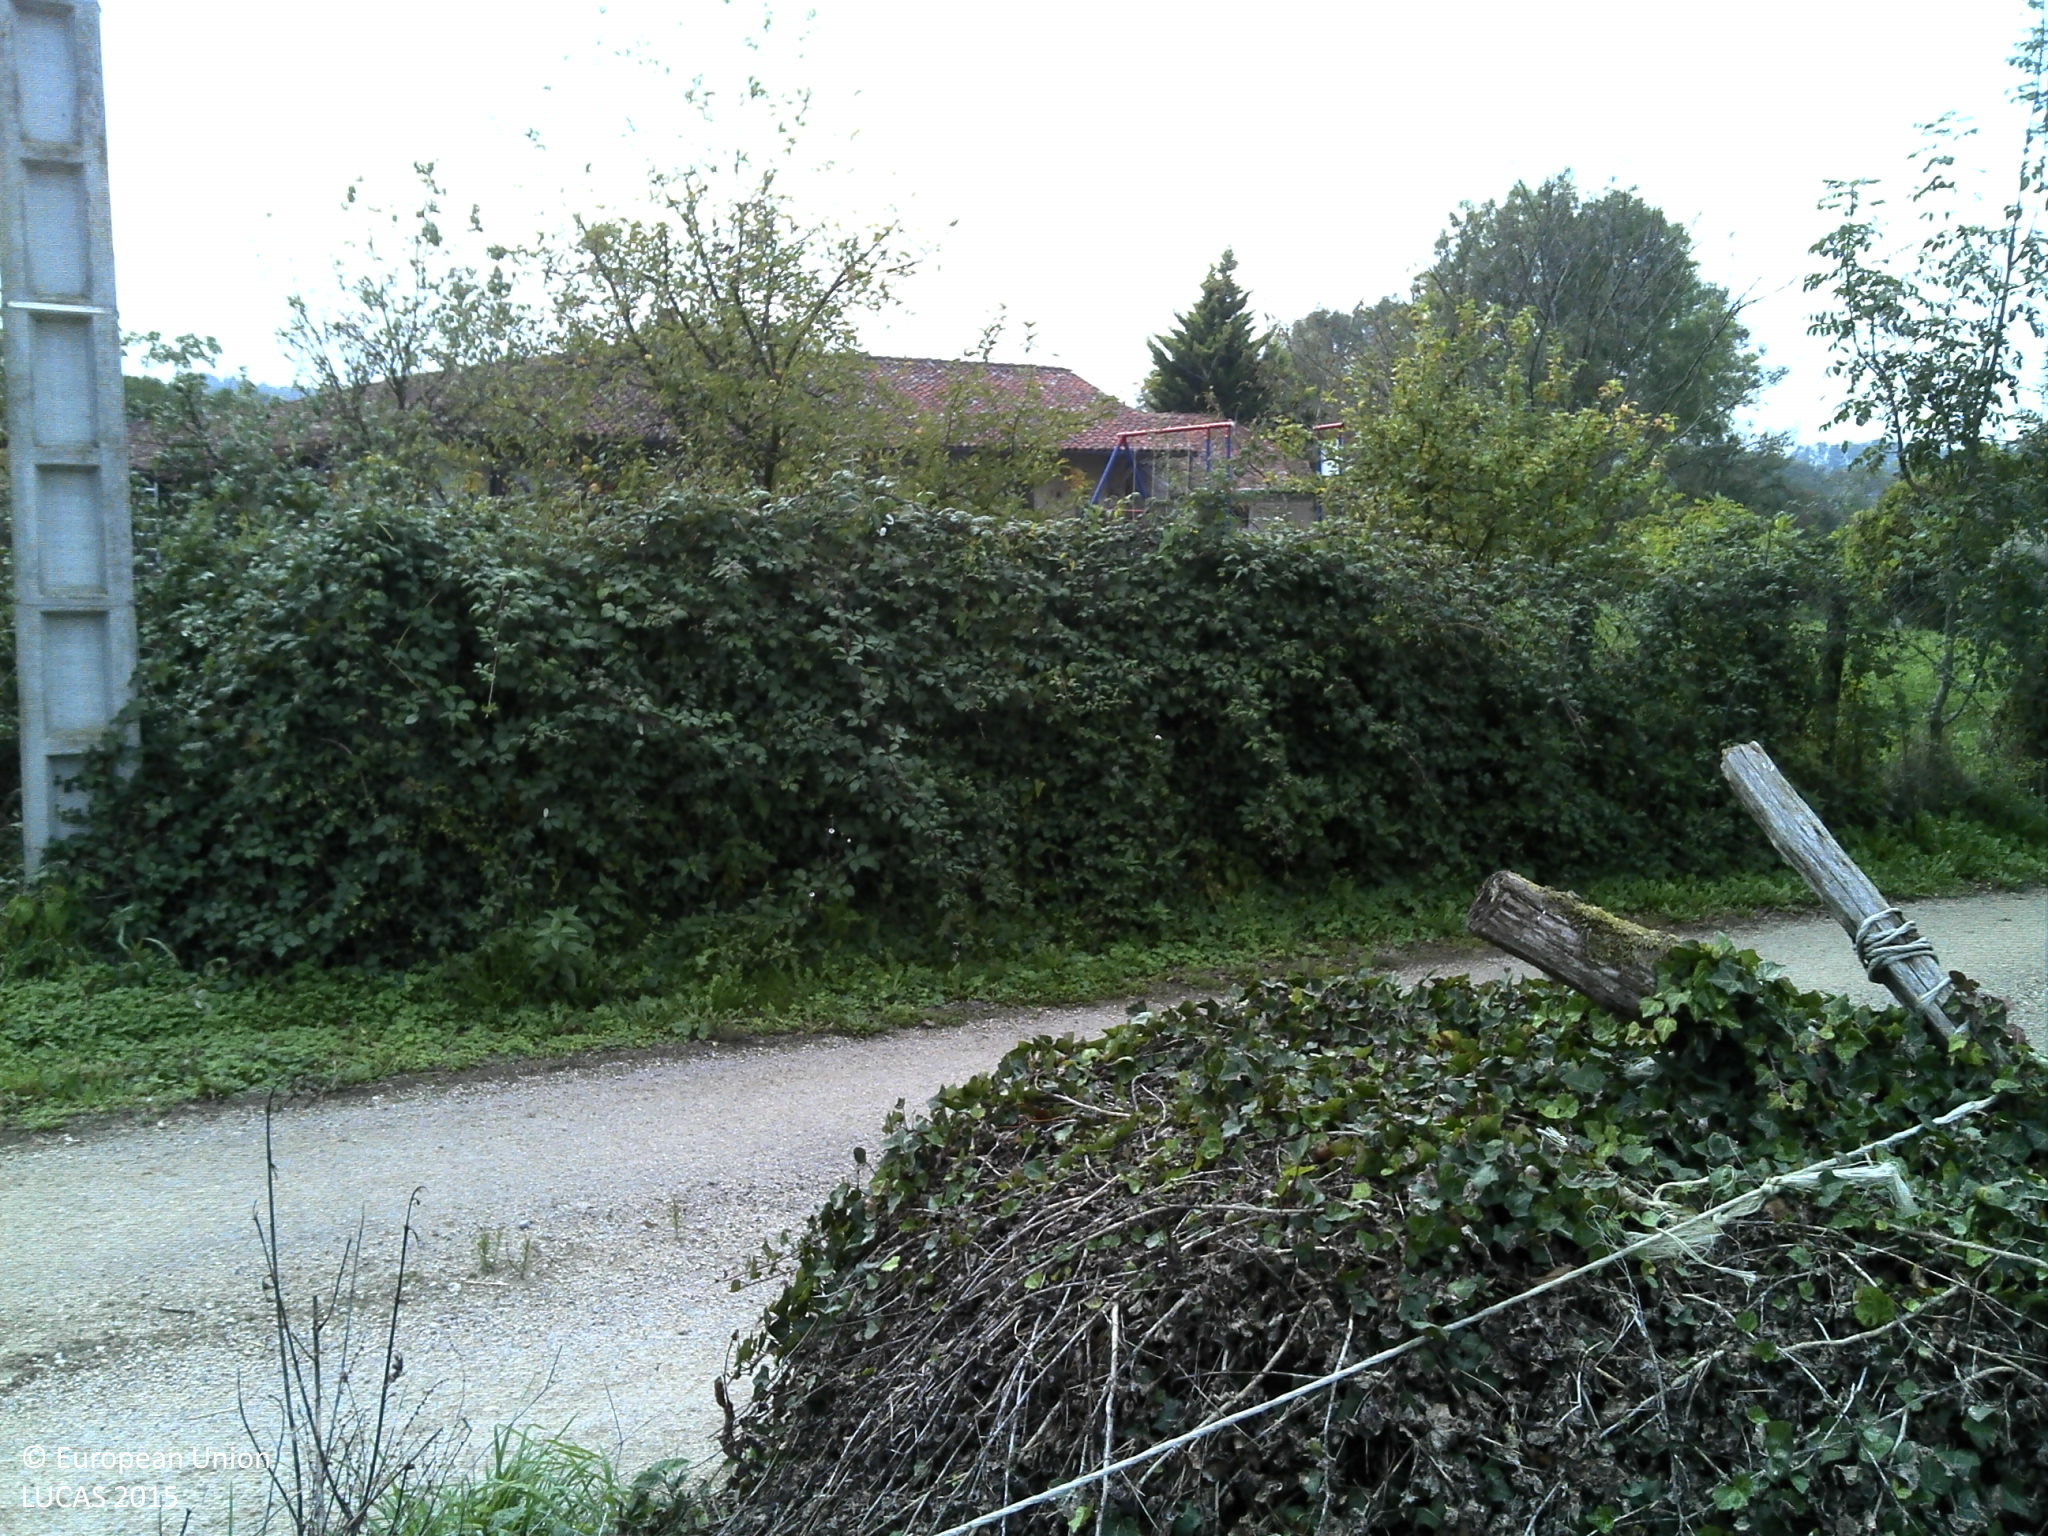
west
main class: Grassland
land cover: Spontaneously vegetated surfaces
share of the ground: > 75 %
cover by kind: herbaceous plants 100 %
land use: Semi-natural and natural areas not in use
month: October
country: FR
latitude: 46.3028
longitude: 5.3158
